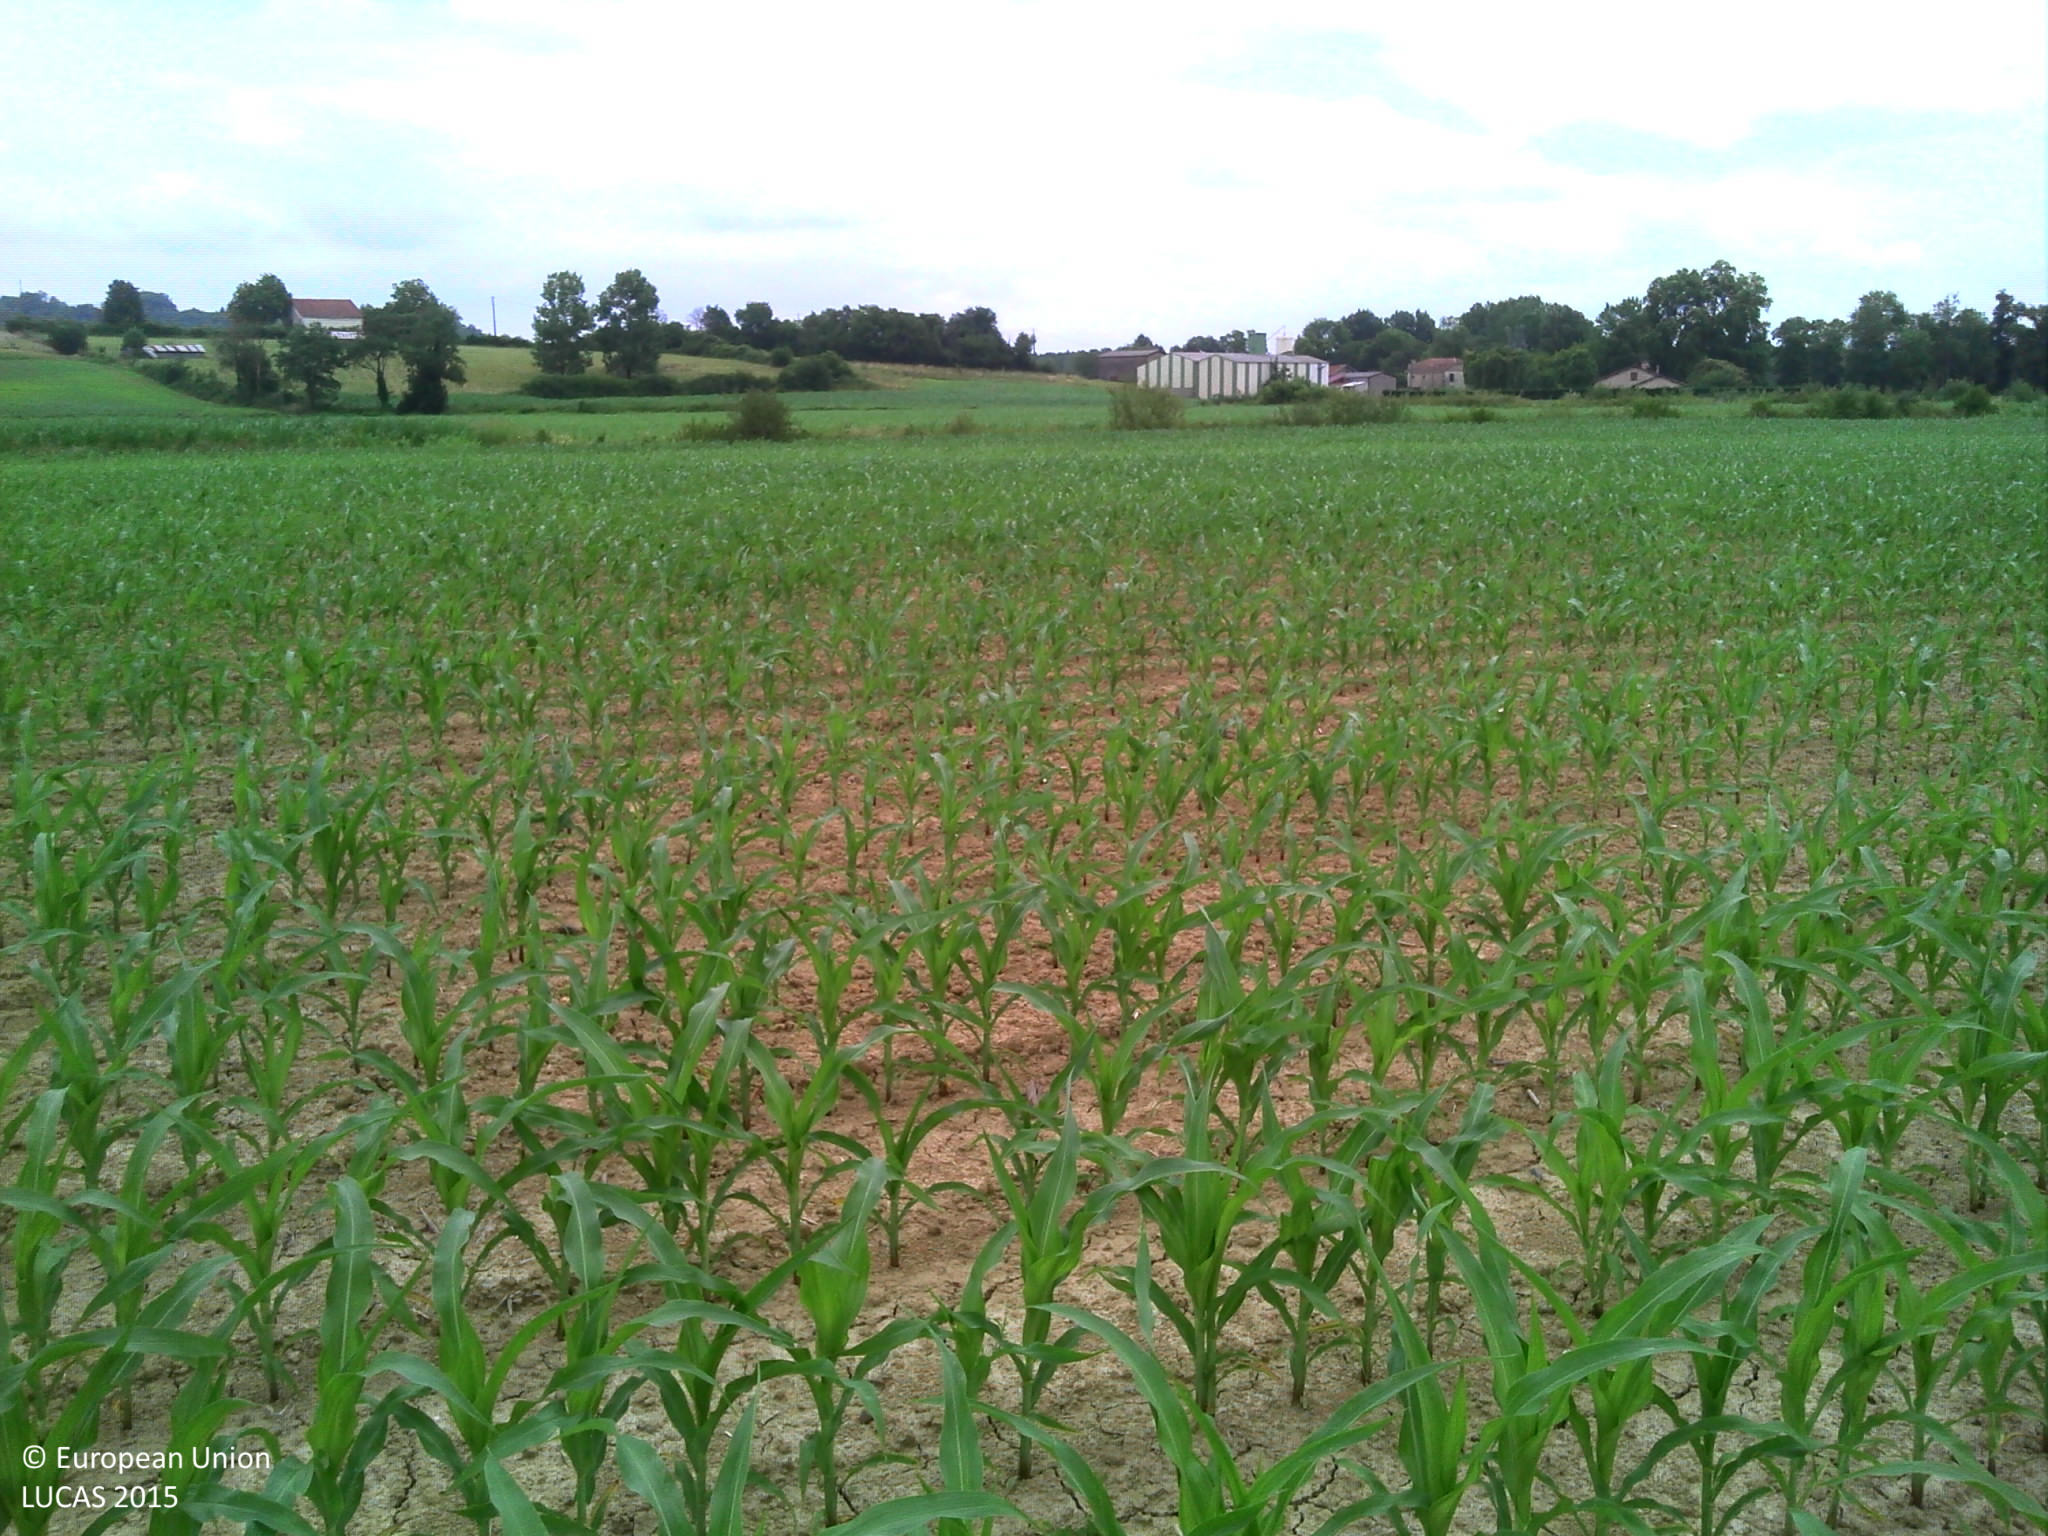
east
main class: Cropland
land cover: Maize
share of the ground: 50 - 75 %
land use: Agriculture (excluding fallow land and kitchen gardens)
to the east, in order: Maize; Rivers and streams; Abandoned hedges; Maize; Rivers and streams; Abandoned hedges; Maize; Rivers and streams; Abandoned hedges; Maize
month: July
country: FR
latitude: 43.6235
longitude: -0.7818
